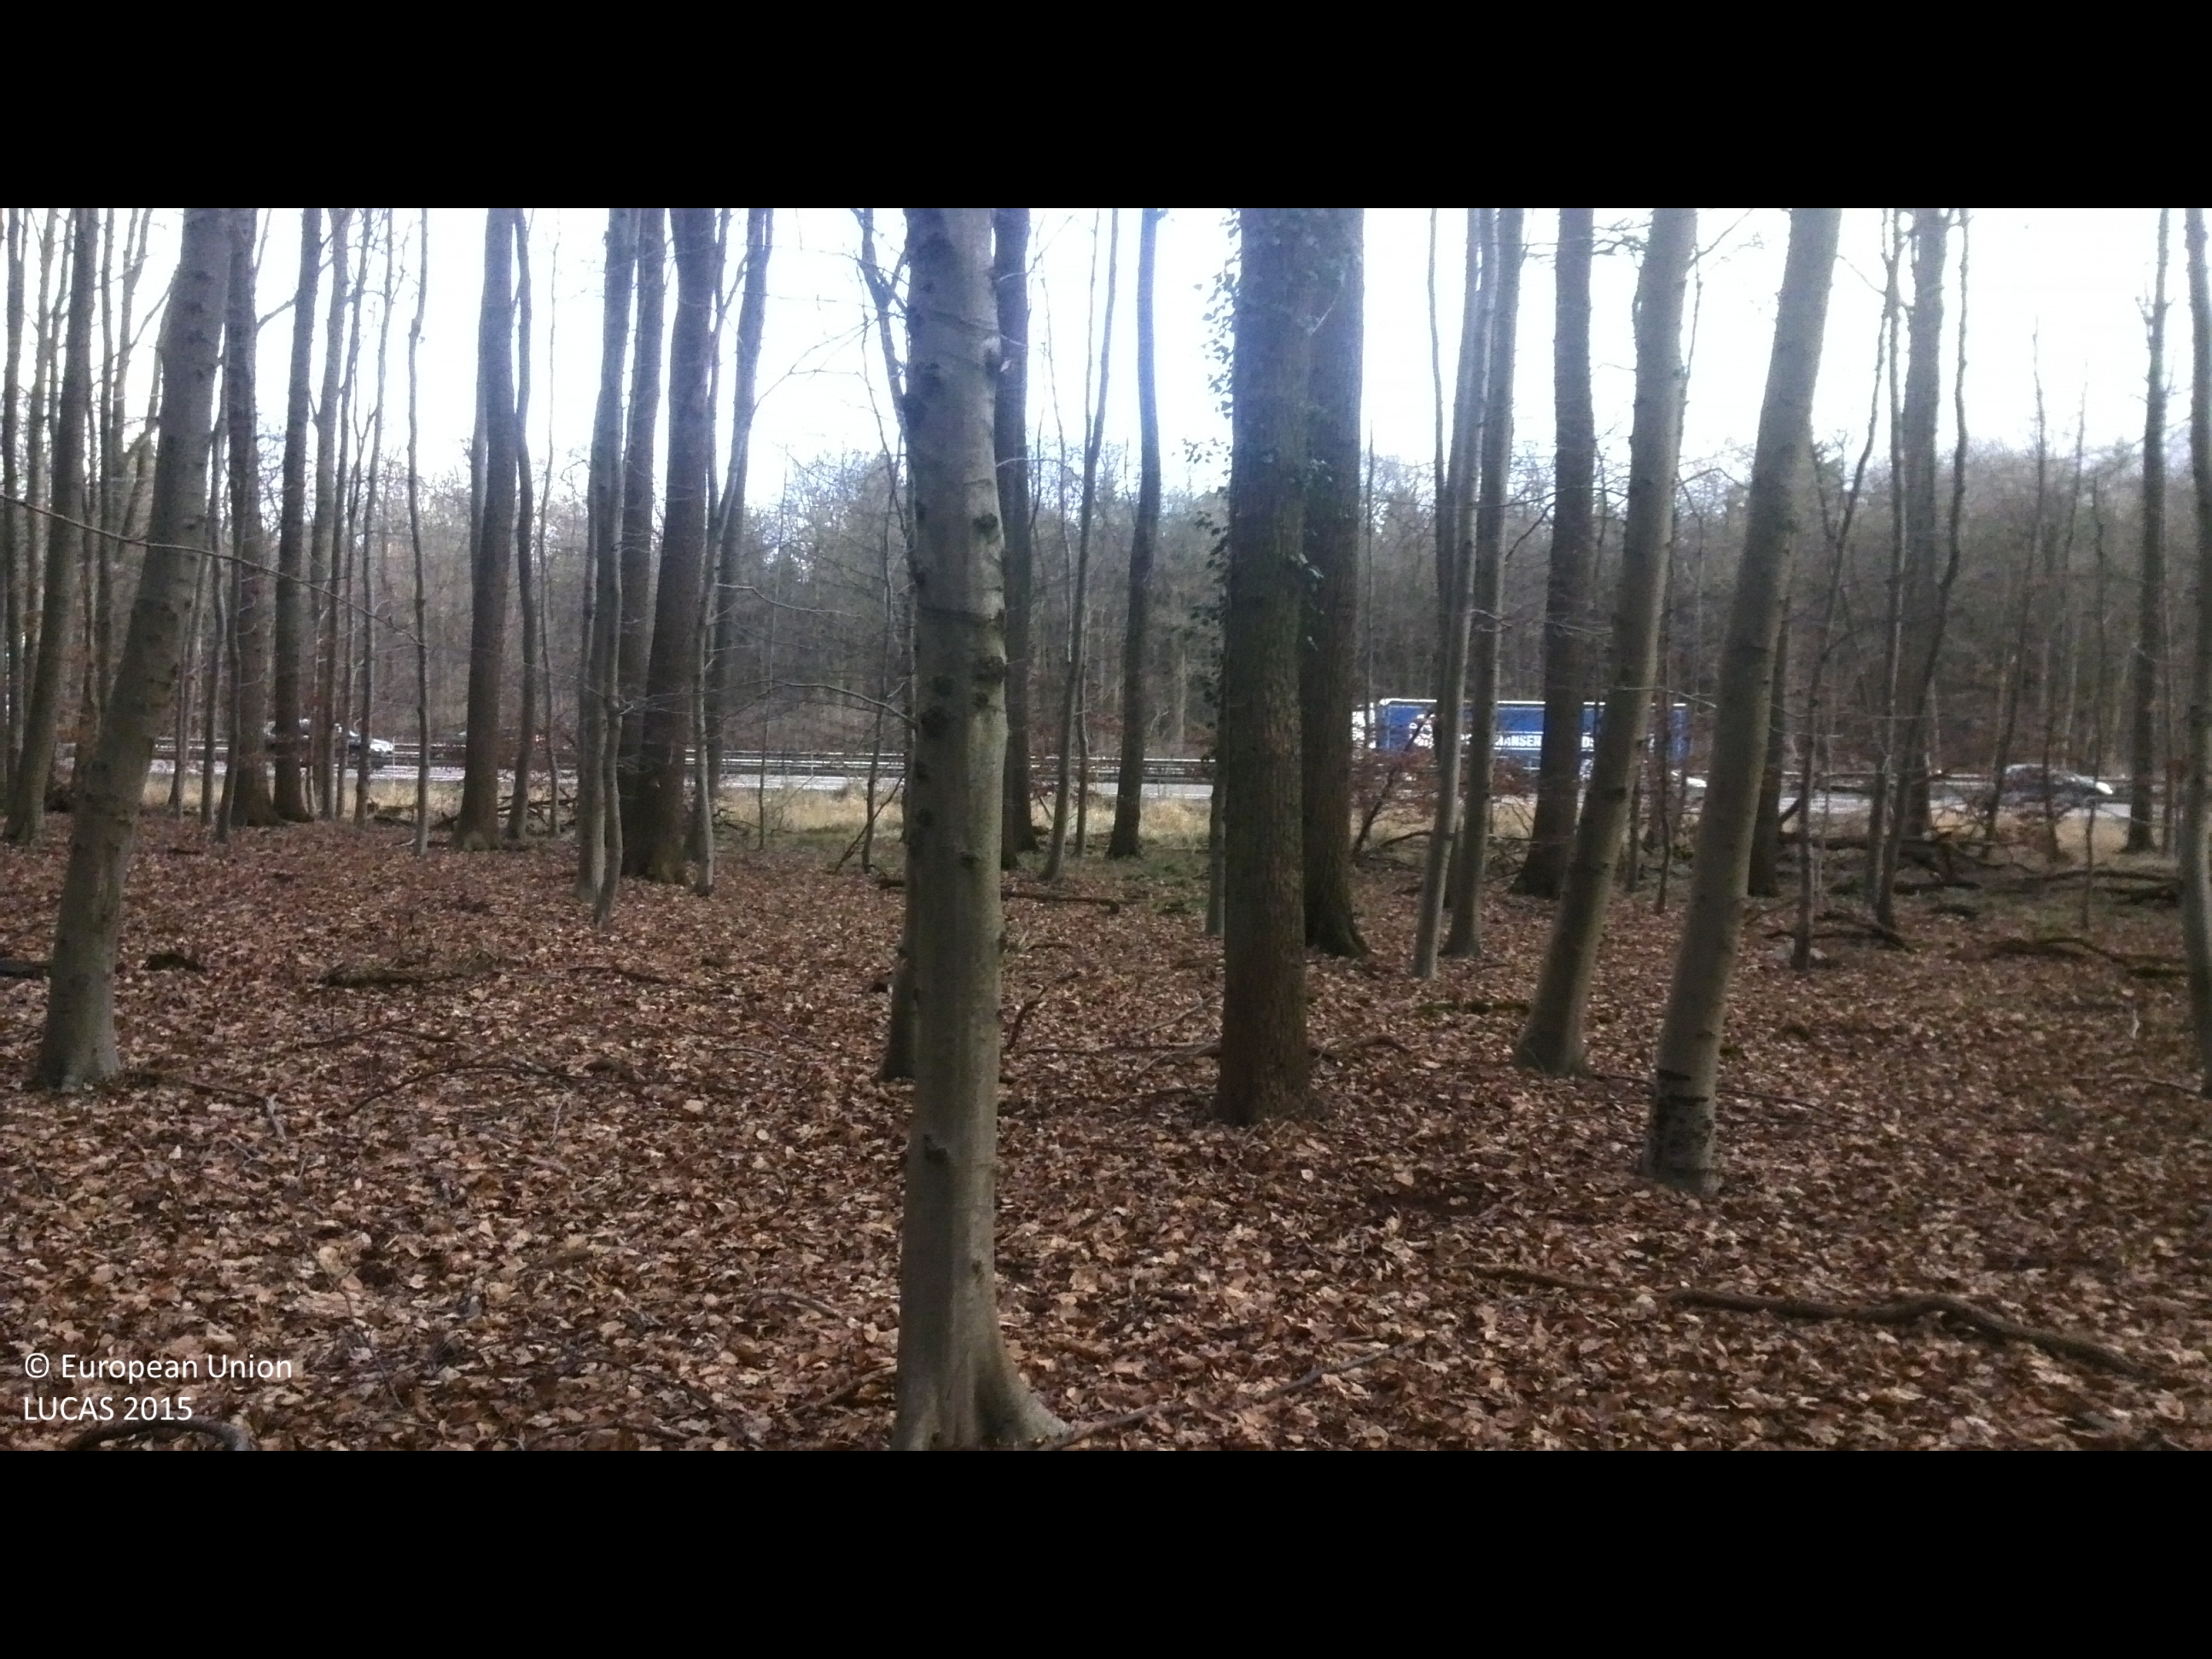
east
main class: Woodland
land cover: Broadleaved woodland
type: beech forest
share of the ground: > 75 %
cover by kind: broadleaved forest trees 100 %
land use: Forestry
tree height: > 5 m
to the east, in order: Broadleaved woodland; Fences; Paved roads, cycling and walking lanes; Fences; Broadleaved woodland; Pine dominated mixed woodland
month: January
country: DE
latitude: 53.6891
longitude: 10.3178
